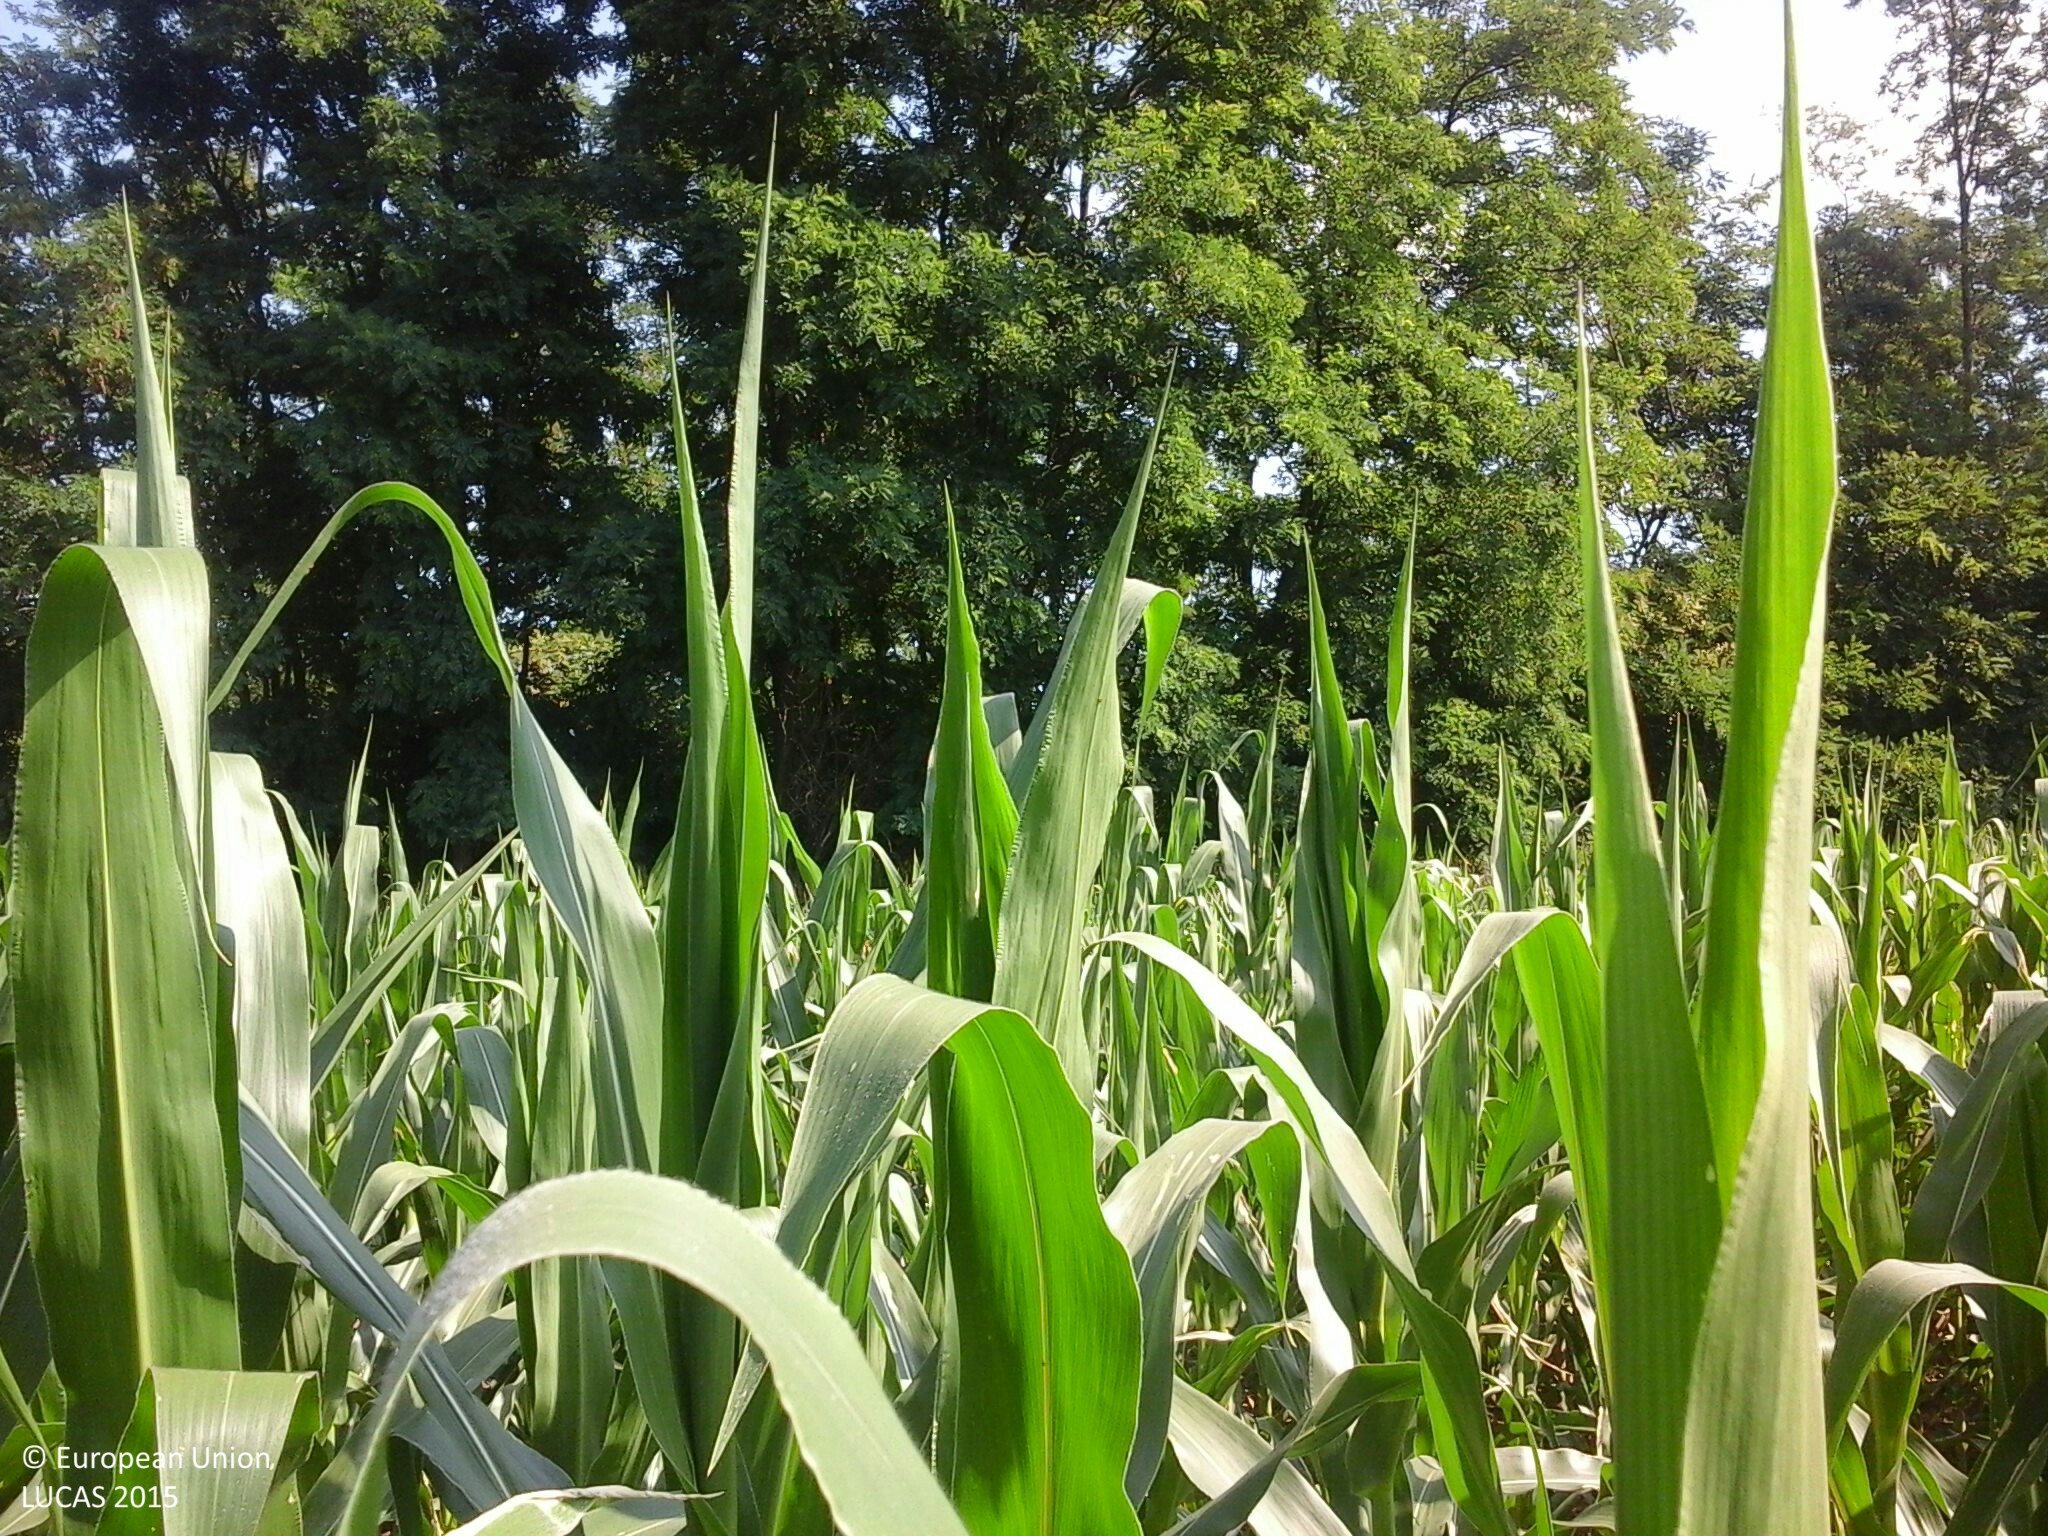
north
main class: Cropland
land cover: Maize
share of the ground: 50 - 75 %
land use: Agriculture (excluding fallow land and kitchen gardens)
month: July
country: HU
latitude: 47.8986
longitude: 21.7796
